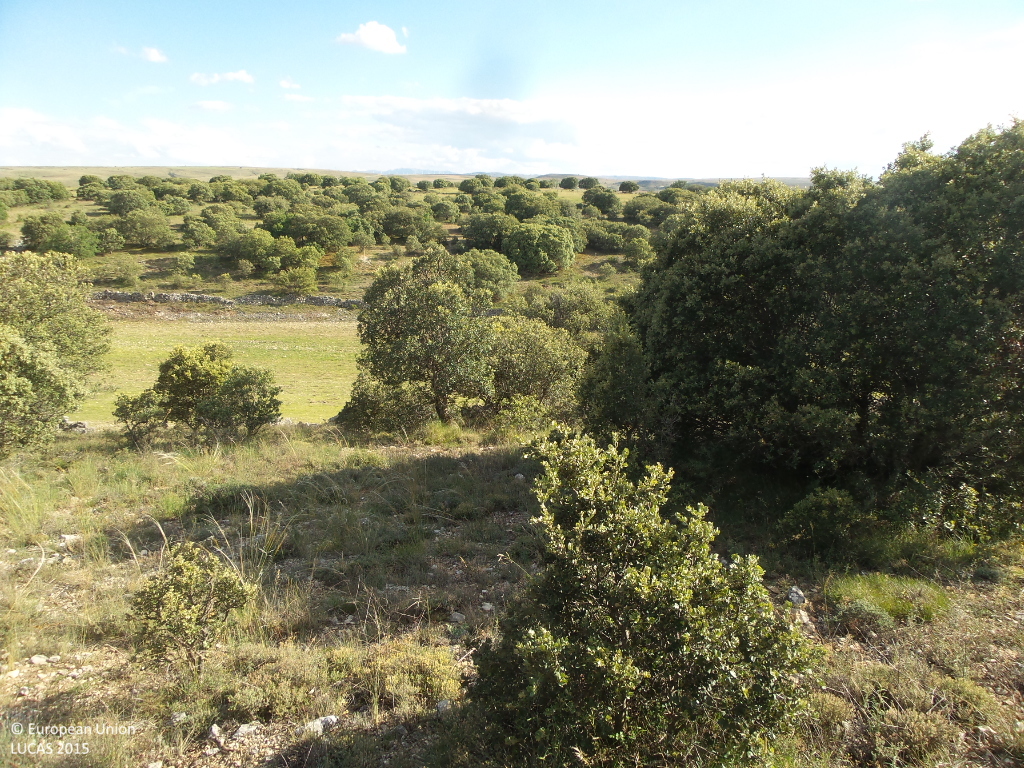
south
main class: Woodland
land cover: Broadleaved woodland
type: broadleaved evergreen forest
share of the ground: 50 - 75 %
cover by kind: broadleaved forest trees 50 %, shrubs 30 %, herbaceous plants 10 %, unconsolidated bare surface 10 %
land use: Semi-natural and natural areas not in use
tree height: < 5 m
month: June
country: ES
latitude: 41.3783
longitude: -2.9653
